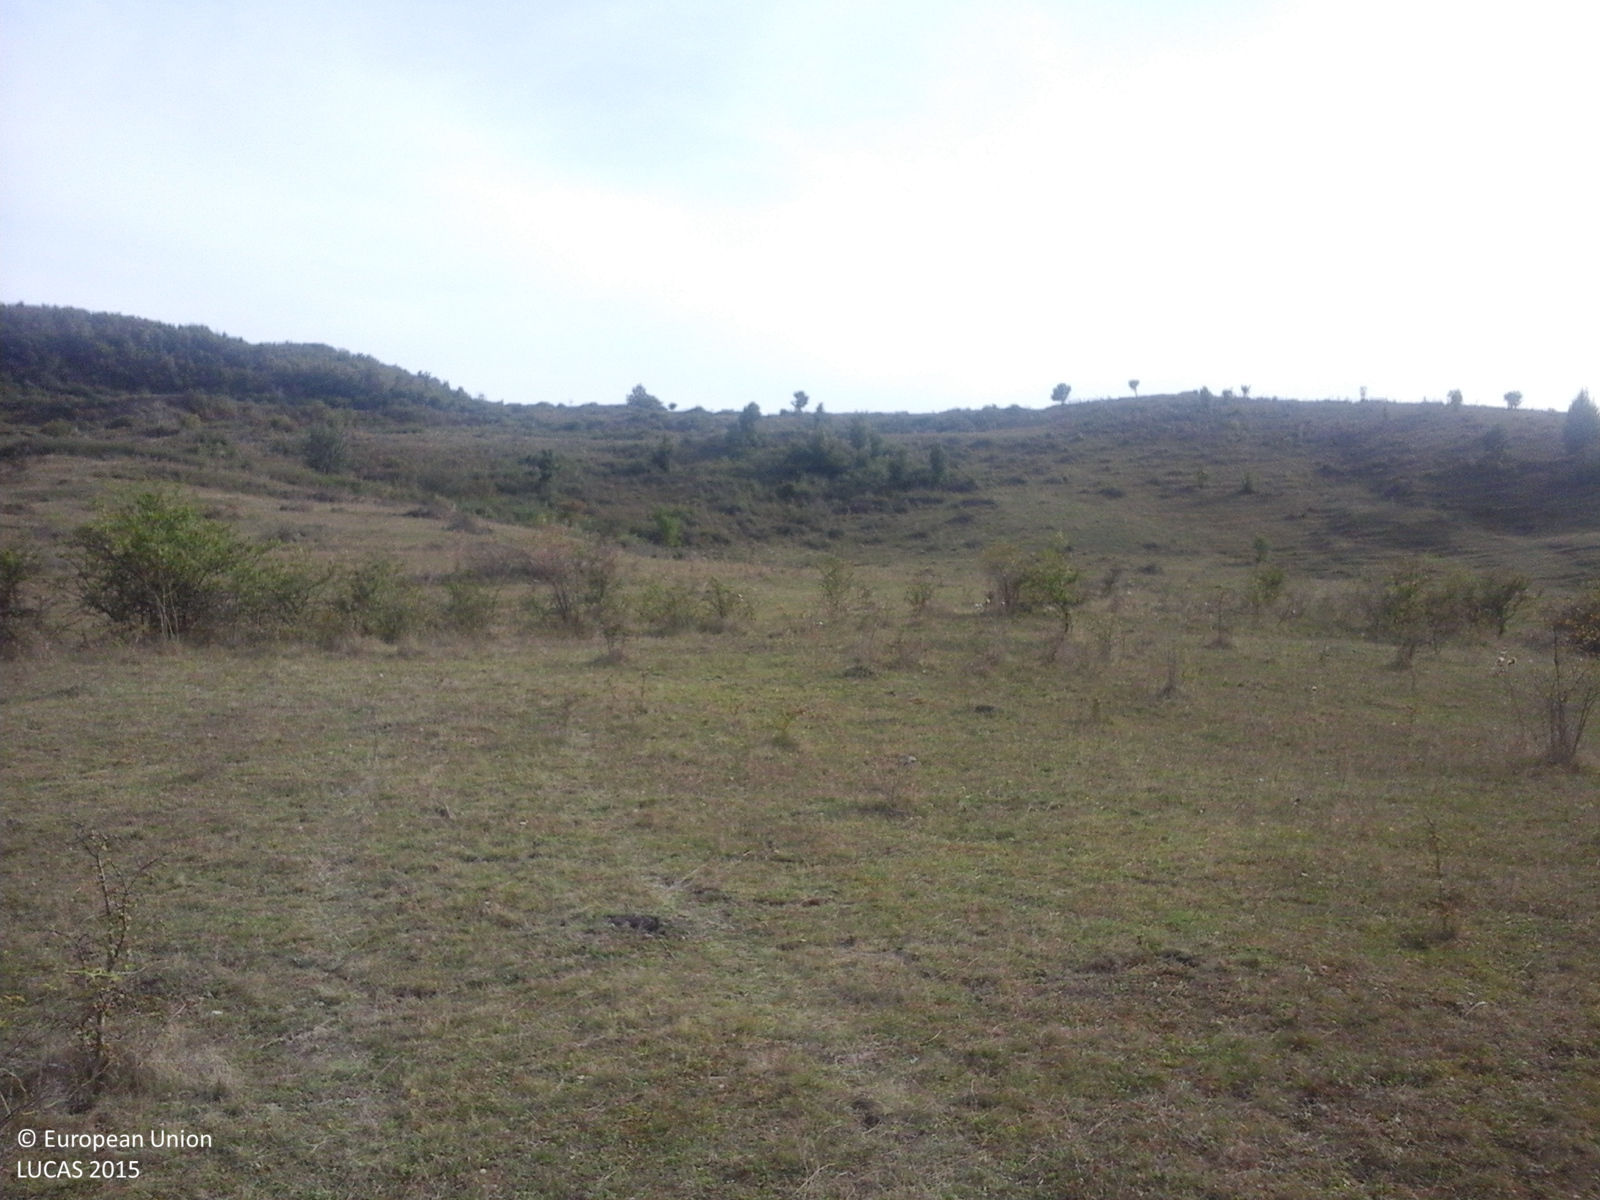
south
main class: Grassland
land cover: Grassland with sparse tree/shrub cover
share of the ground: > 75 %
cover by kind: herbaceous plants 85 %, shrubs 10 %, broadleaved forest trees 5 %
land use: Agriculture (excluding fallow land and kitchen gardens)
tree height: < 5 m
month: September
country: RO
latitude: 46.9216
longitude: 23.5847
